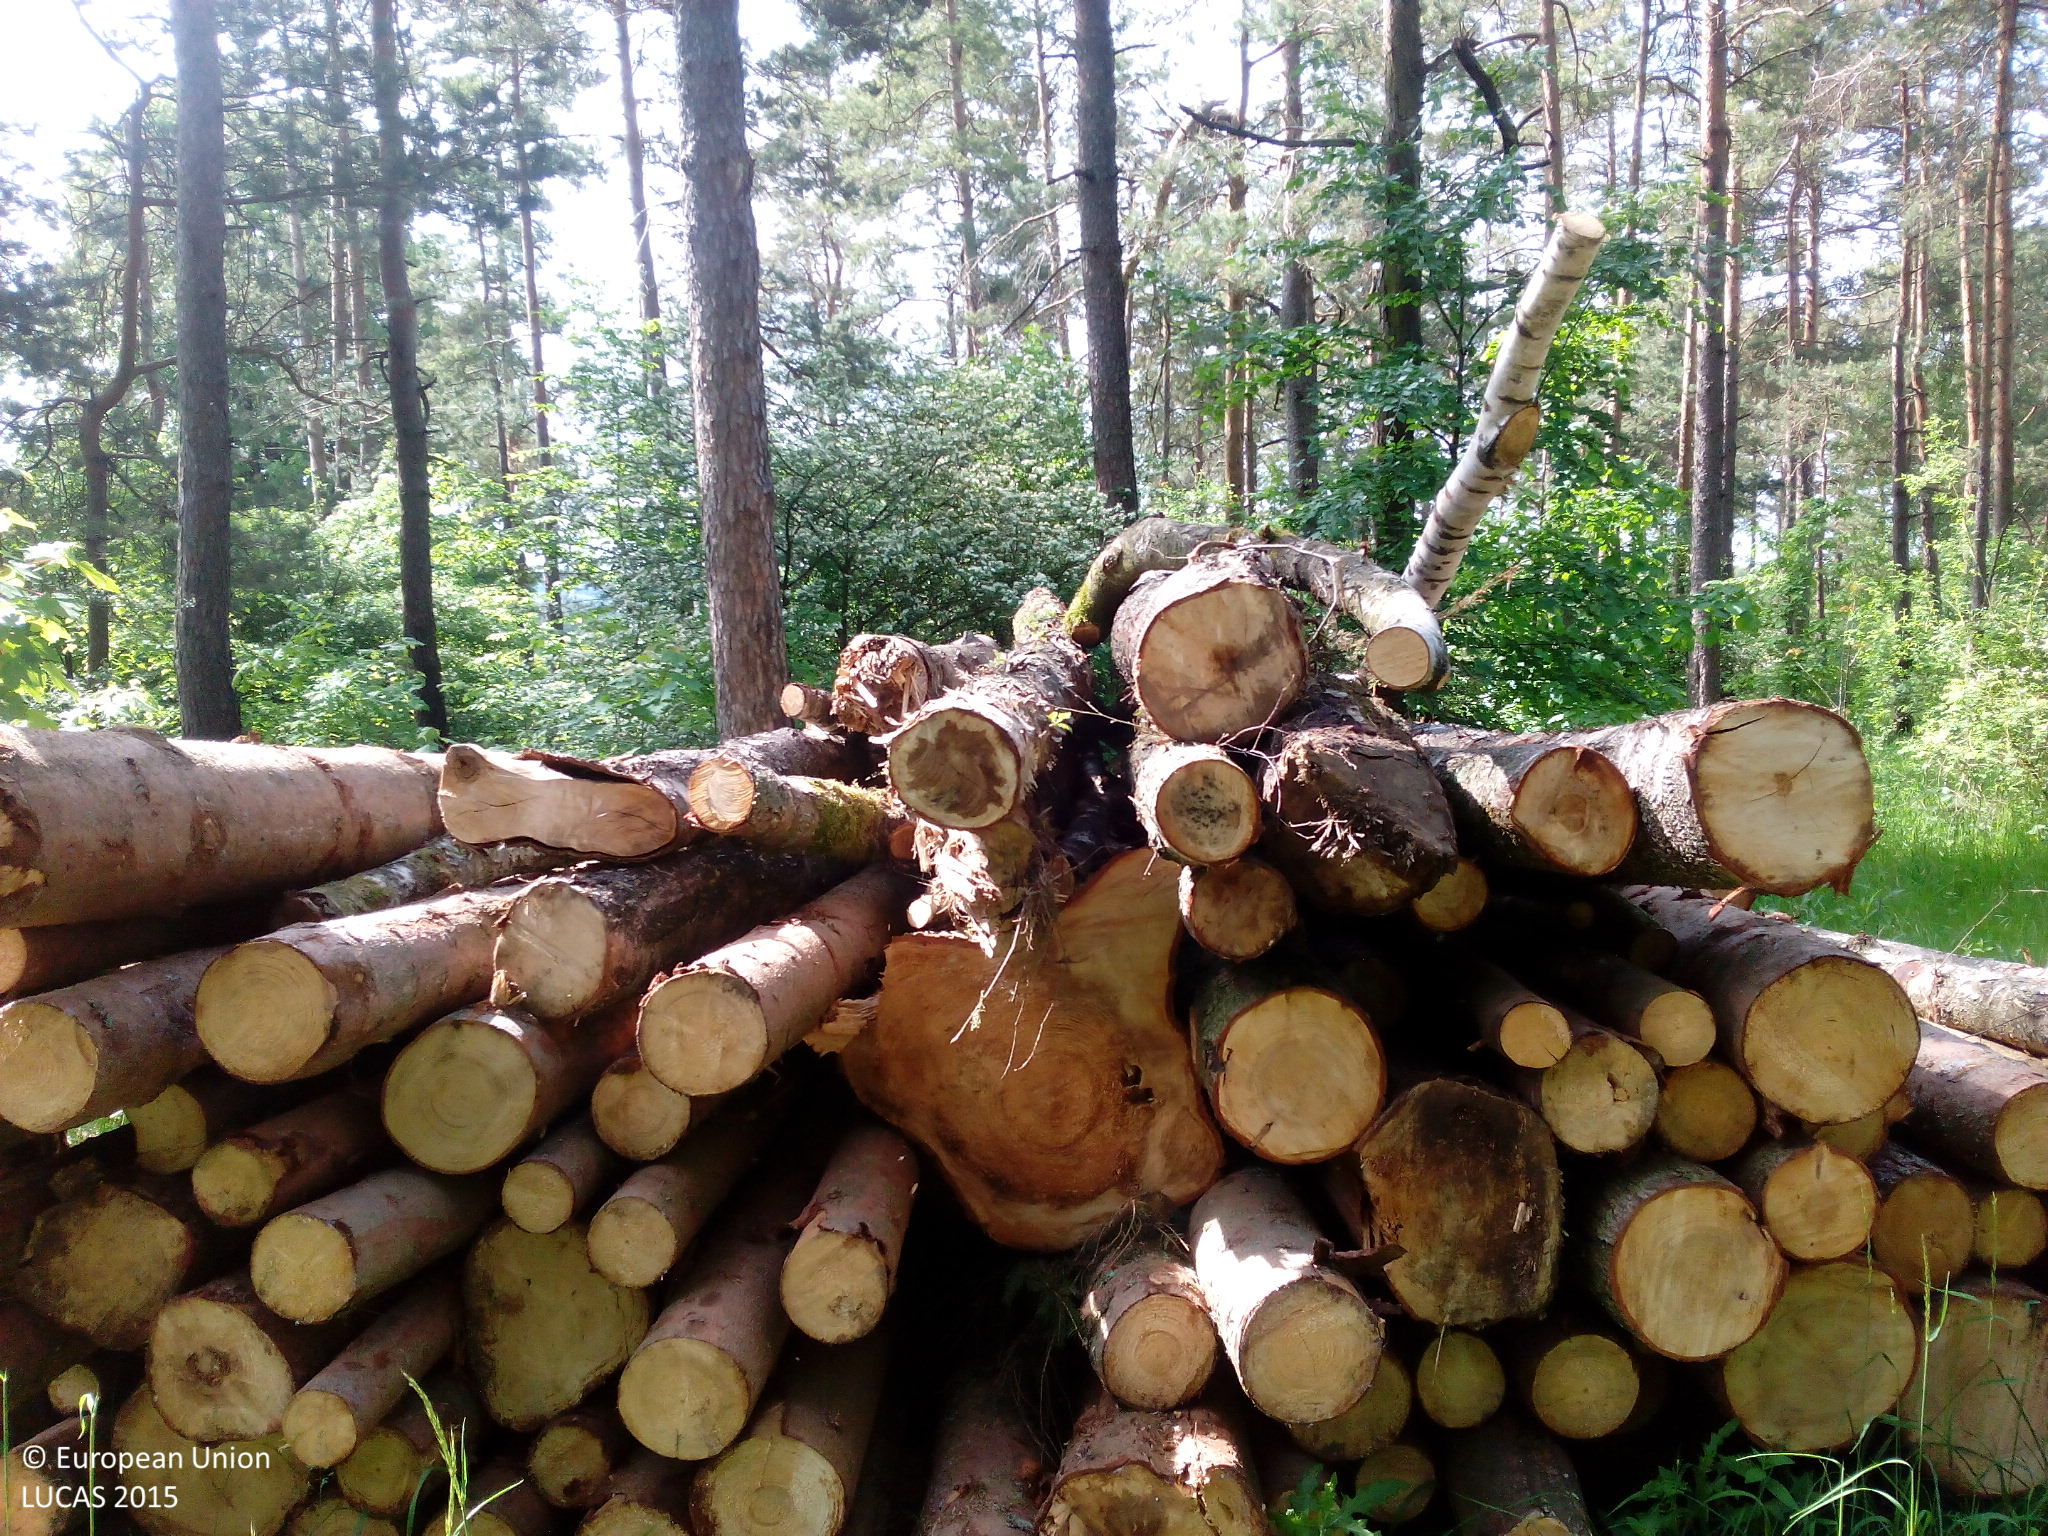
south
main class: Woodland
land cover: Other mixed woodland
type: hemiboreal forest and nemoral coniferous forest and mixed broadleaved-coniferous forest
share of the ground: > 75 %
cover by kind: coniferous forest trees 50 %, broadleaved forest trees 50 %
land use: Forestry
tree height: > 5 m
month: May
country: DE
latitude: 49.7968
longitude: 11.4861
